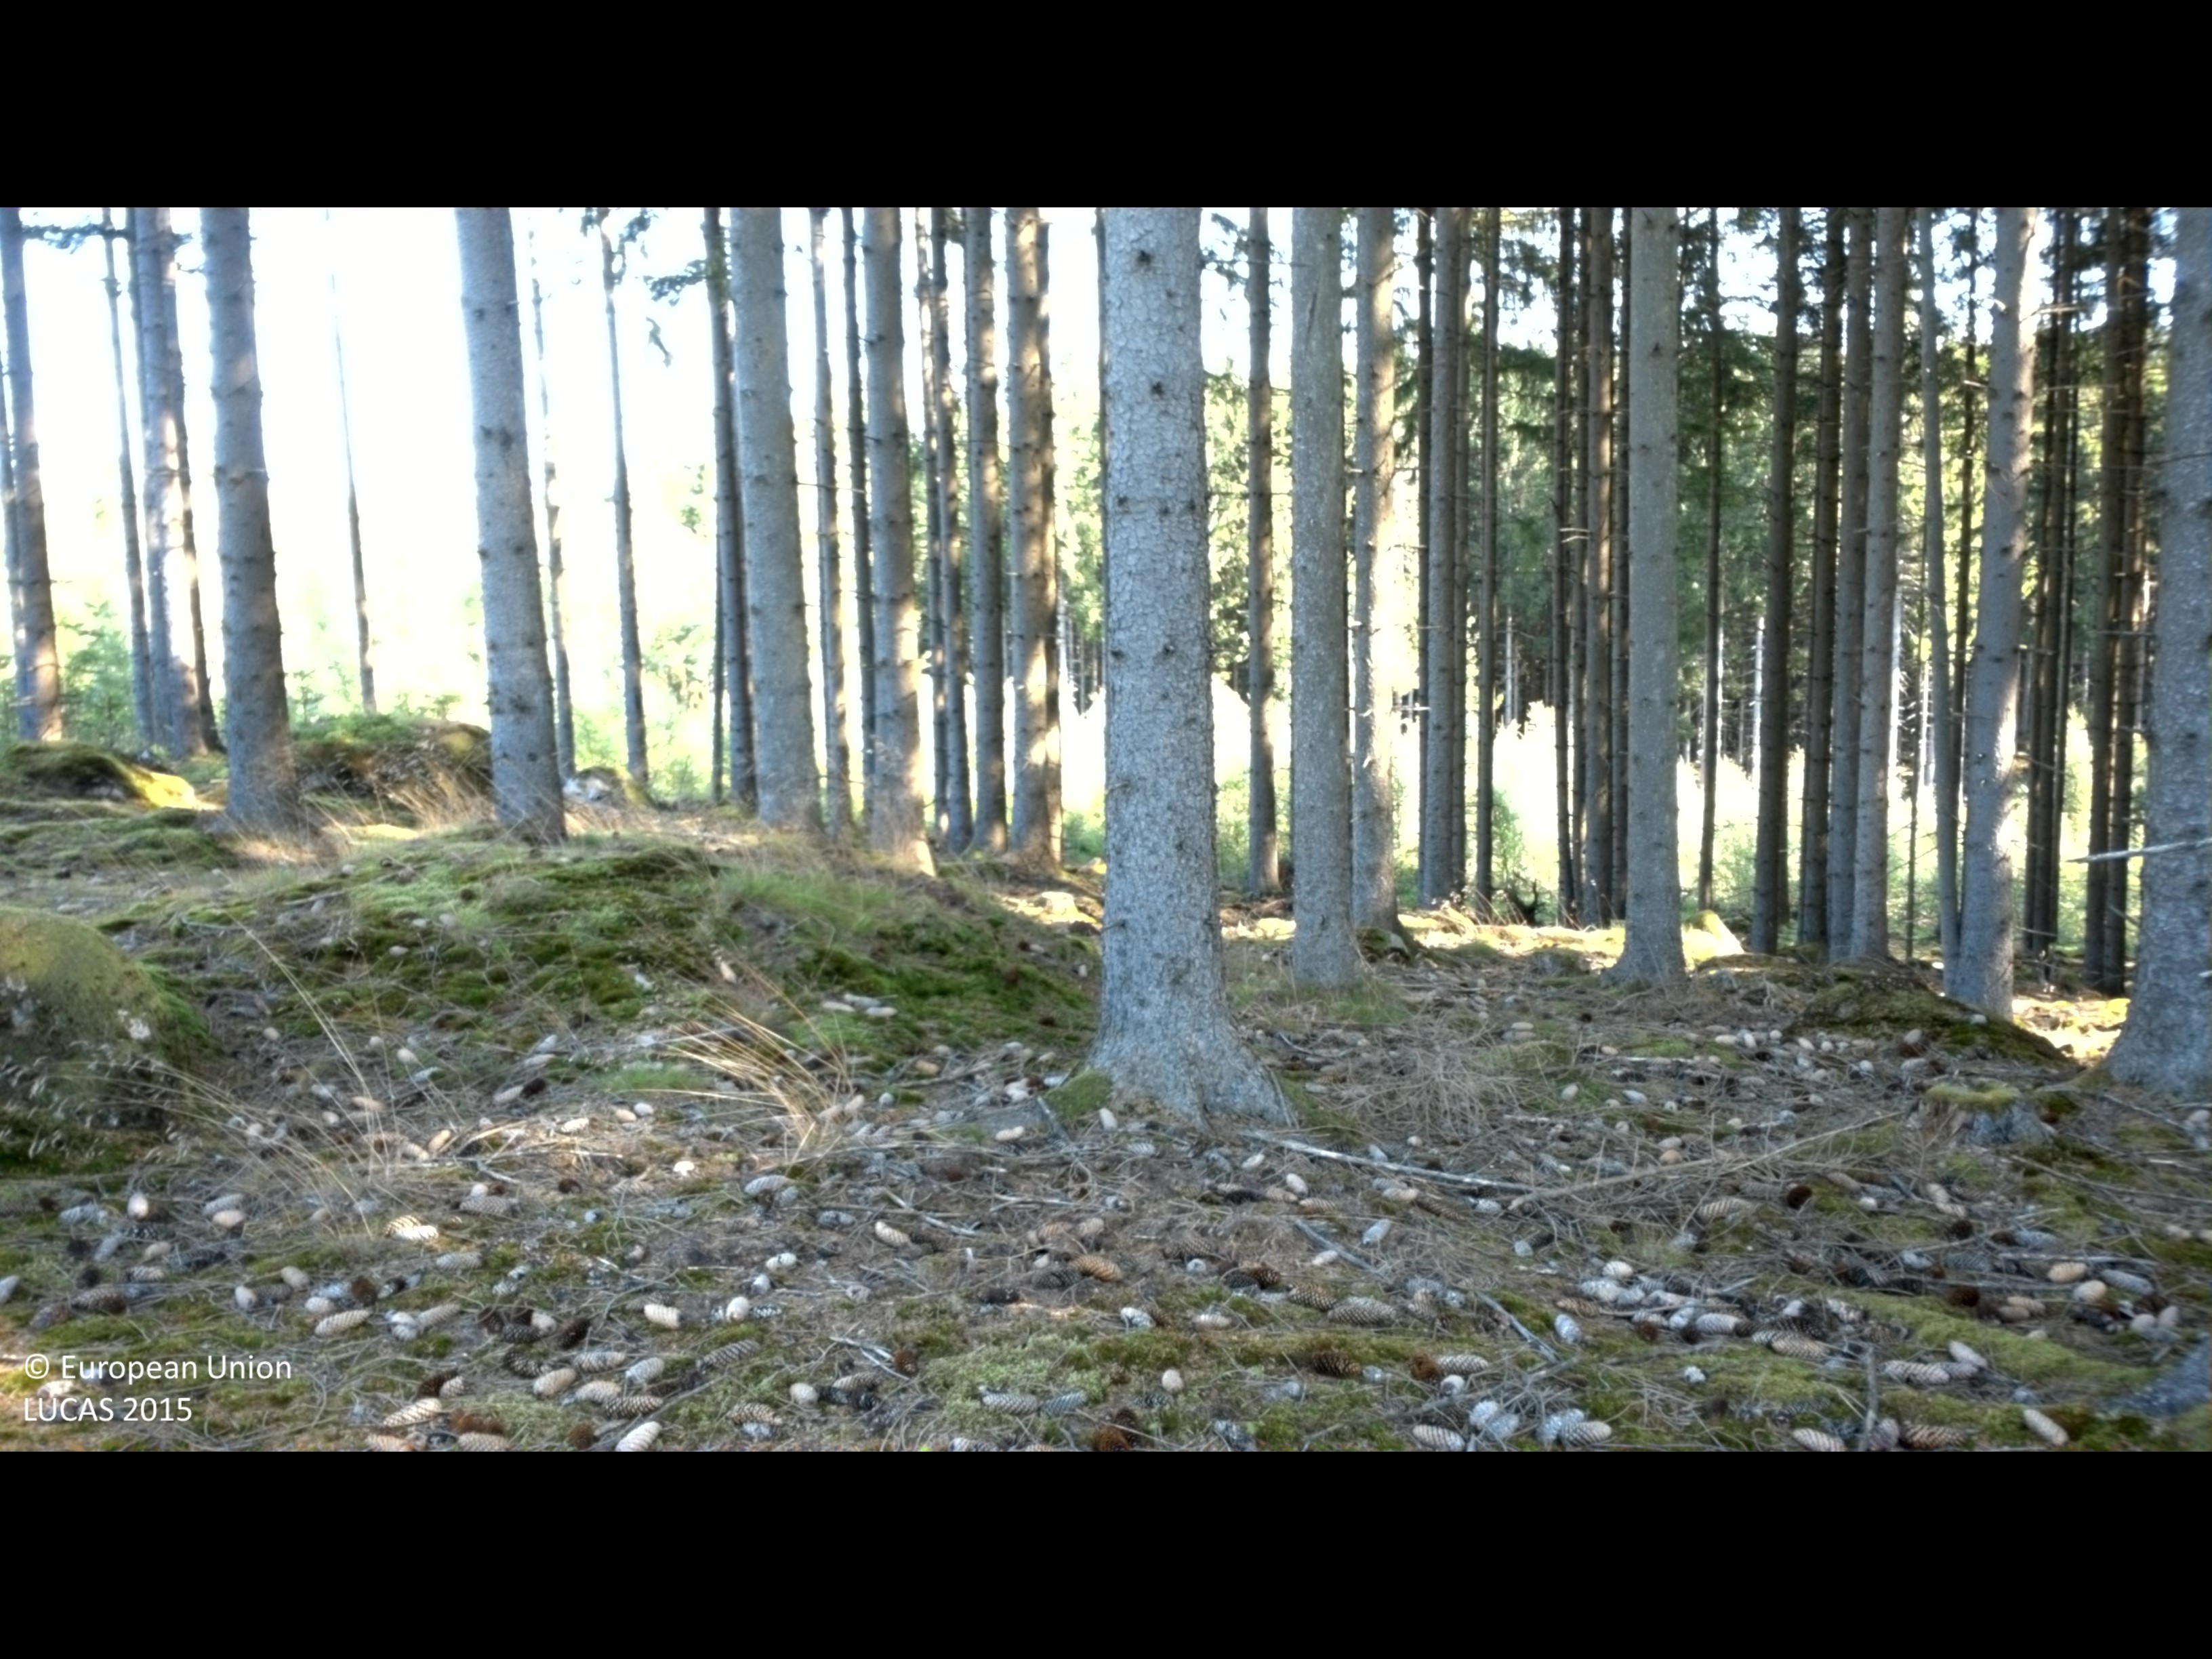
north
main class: Woodland
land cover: Spruce dominated coniferous woodland
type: boreal forest
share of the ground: 50 - 75 %
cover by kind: coniferous forest trees 65 %, lichens and mosses 30 %, consolidated bare surface 5 %
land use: Forestry
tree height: > 5 m
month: August
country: SE
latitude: 56.3033
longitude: 14.6040
